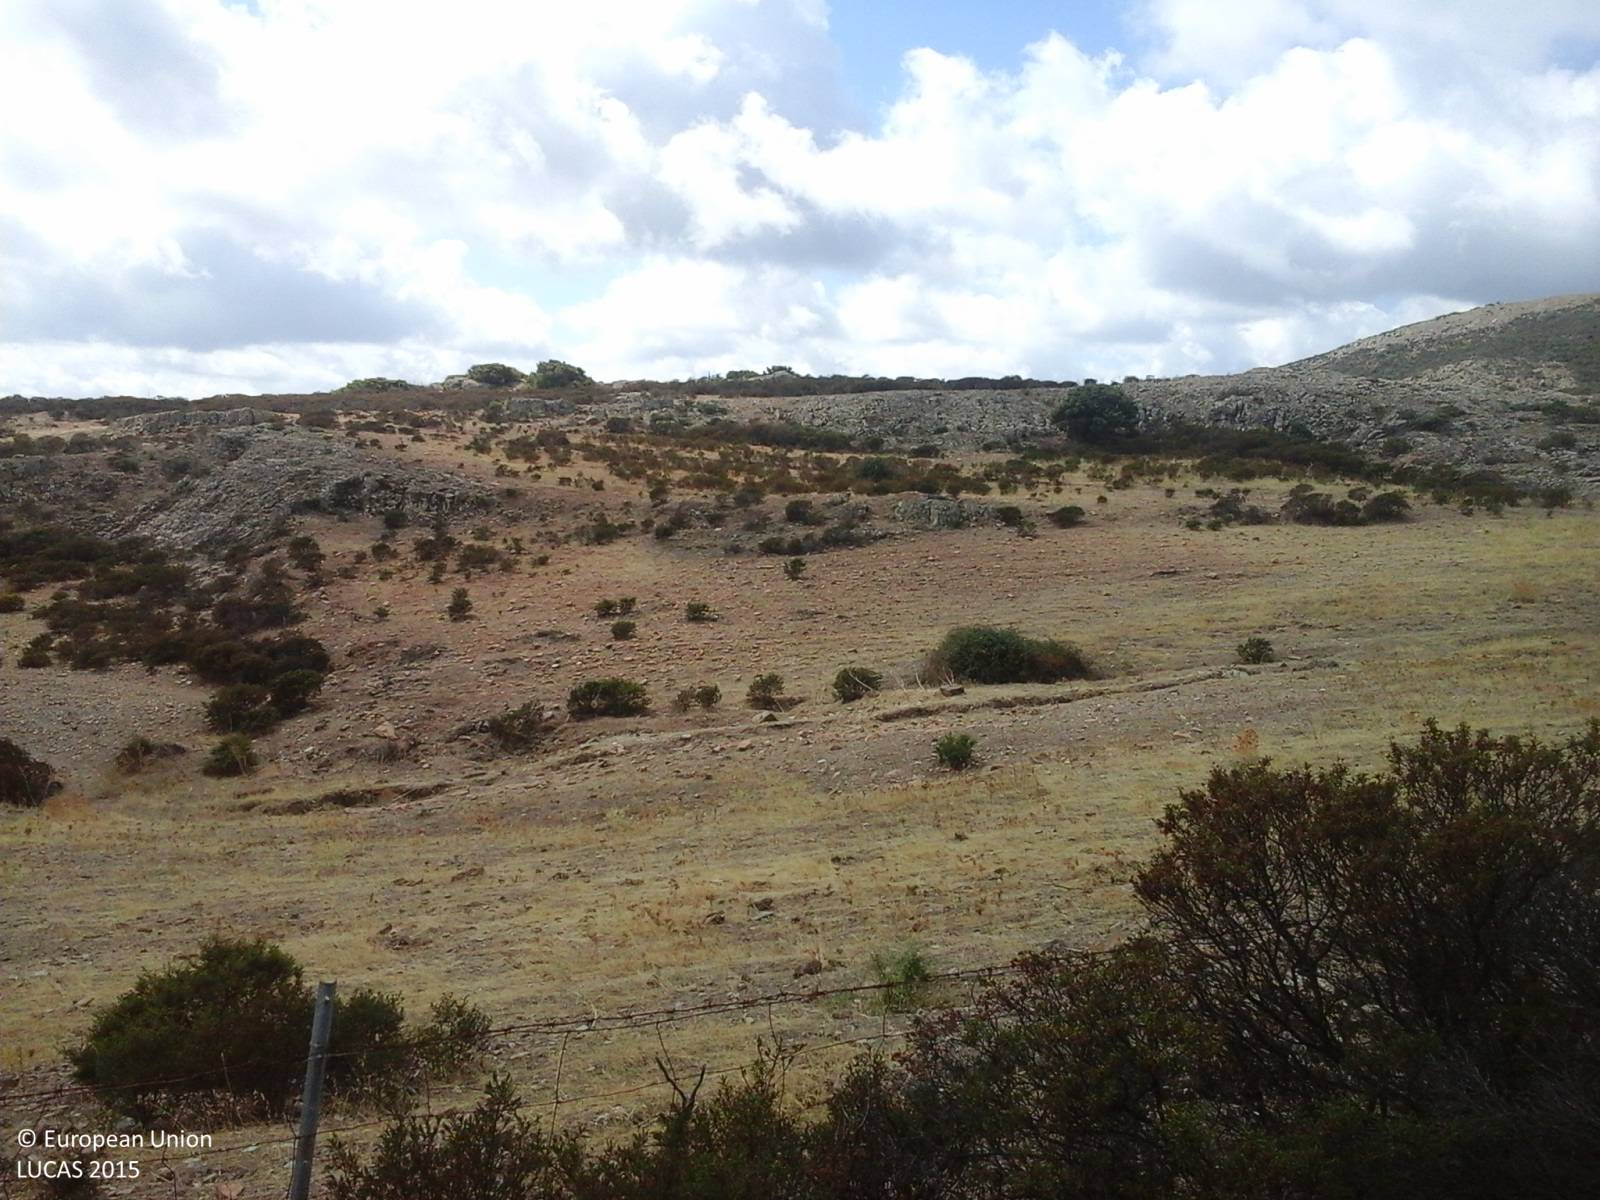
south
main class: Shrubland
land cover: Shrubland without tree cover
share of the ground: > 75 %
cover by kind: shrubs 80 %, herbaceous plants 10 %, unconsolidated bare surface 10 %
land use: Agriculture (excluding fallow land and kitchen gardens)
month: August
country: IT
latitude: 39.7048
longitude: 9.5246
